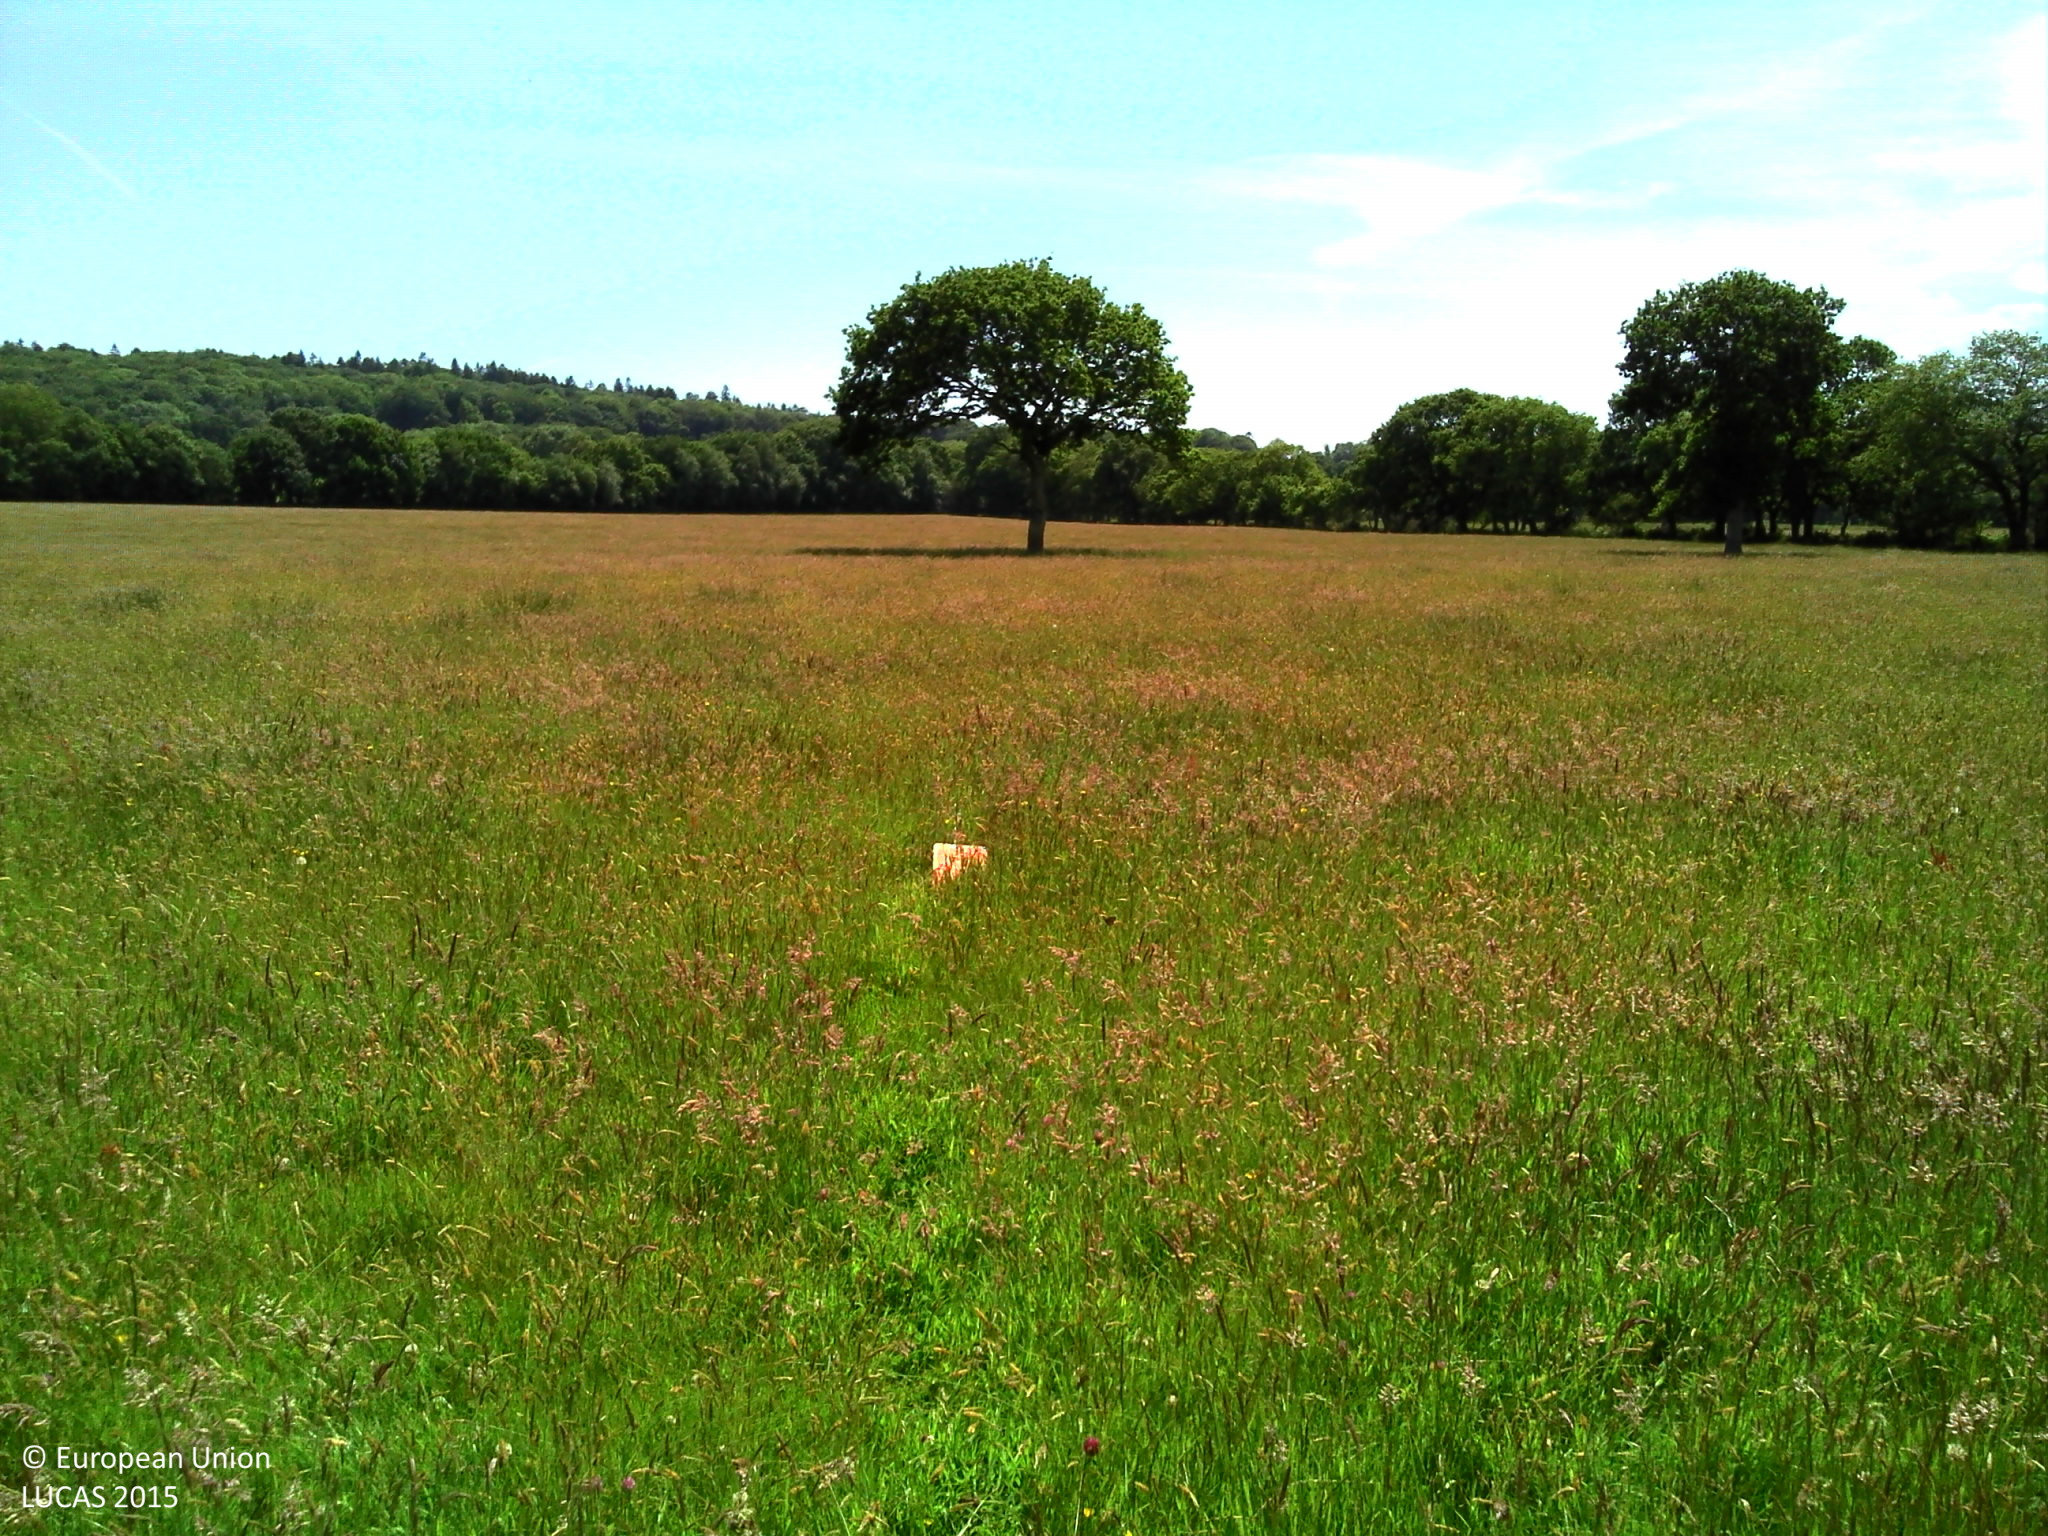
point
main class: Grassland
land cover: Grassland without tree/shrub cover
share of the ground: > 75 %
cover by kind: herbaceous plants 100 %
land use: Agriculture (excluding fallow land and kitchen gardens)
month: June
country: FR
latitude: 49.3088
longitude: -1.5065
